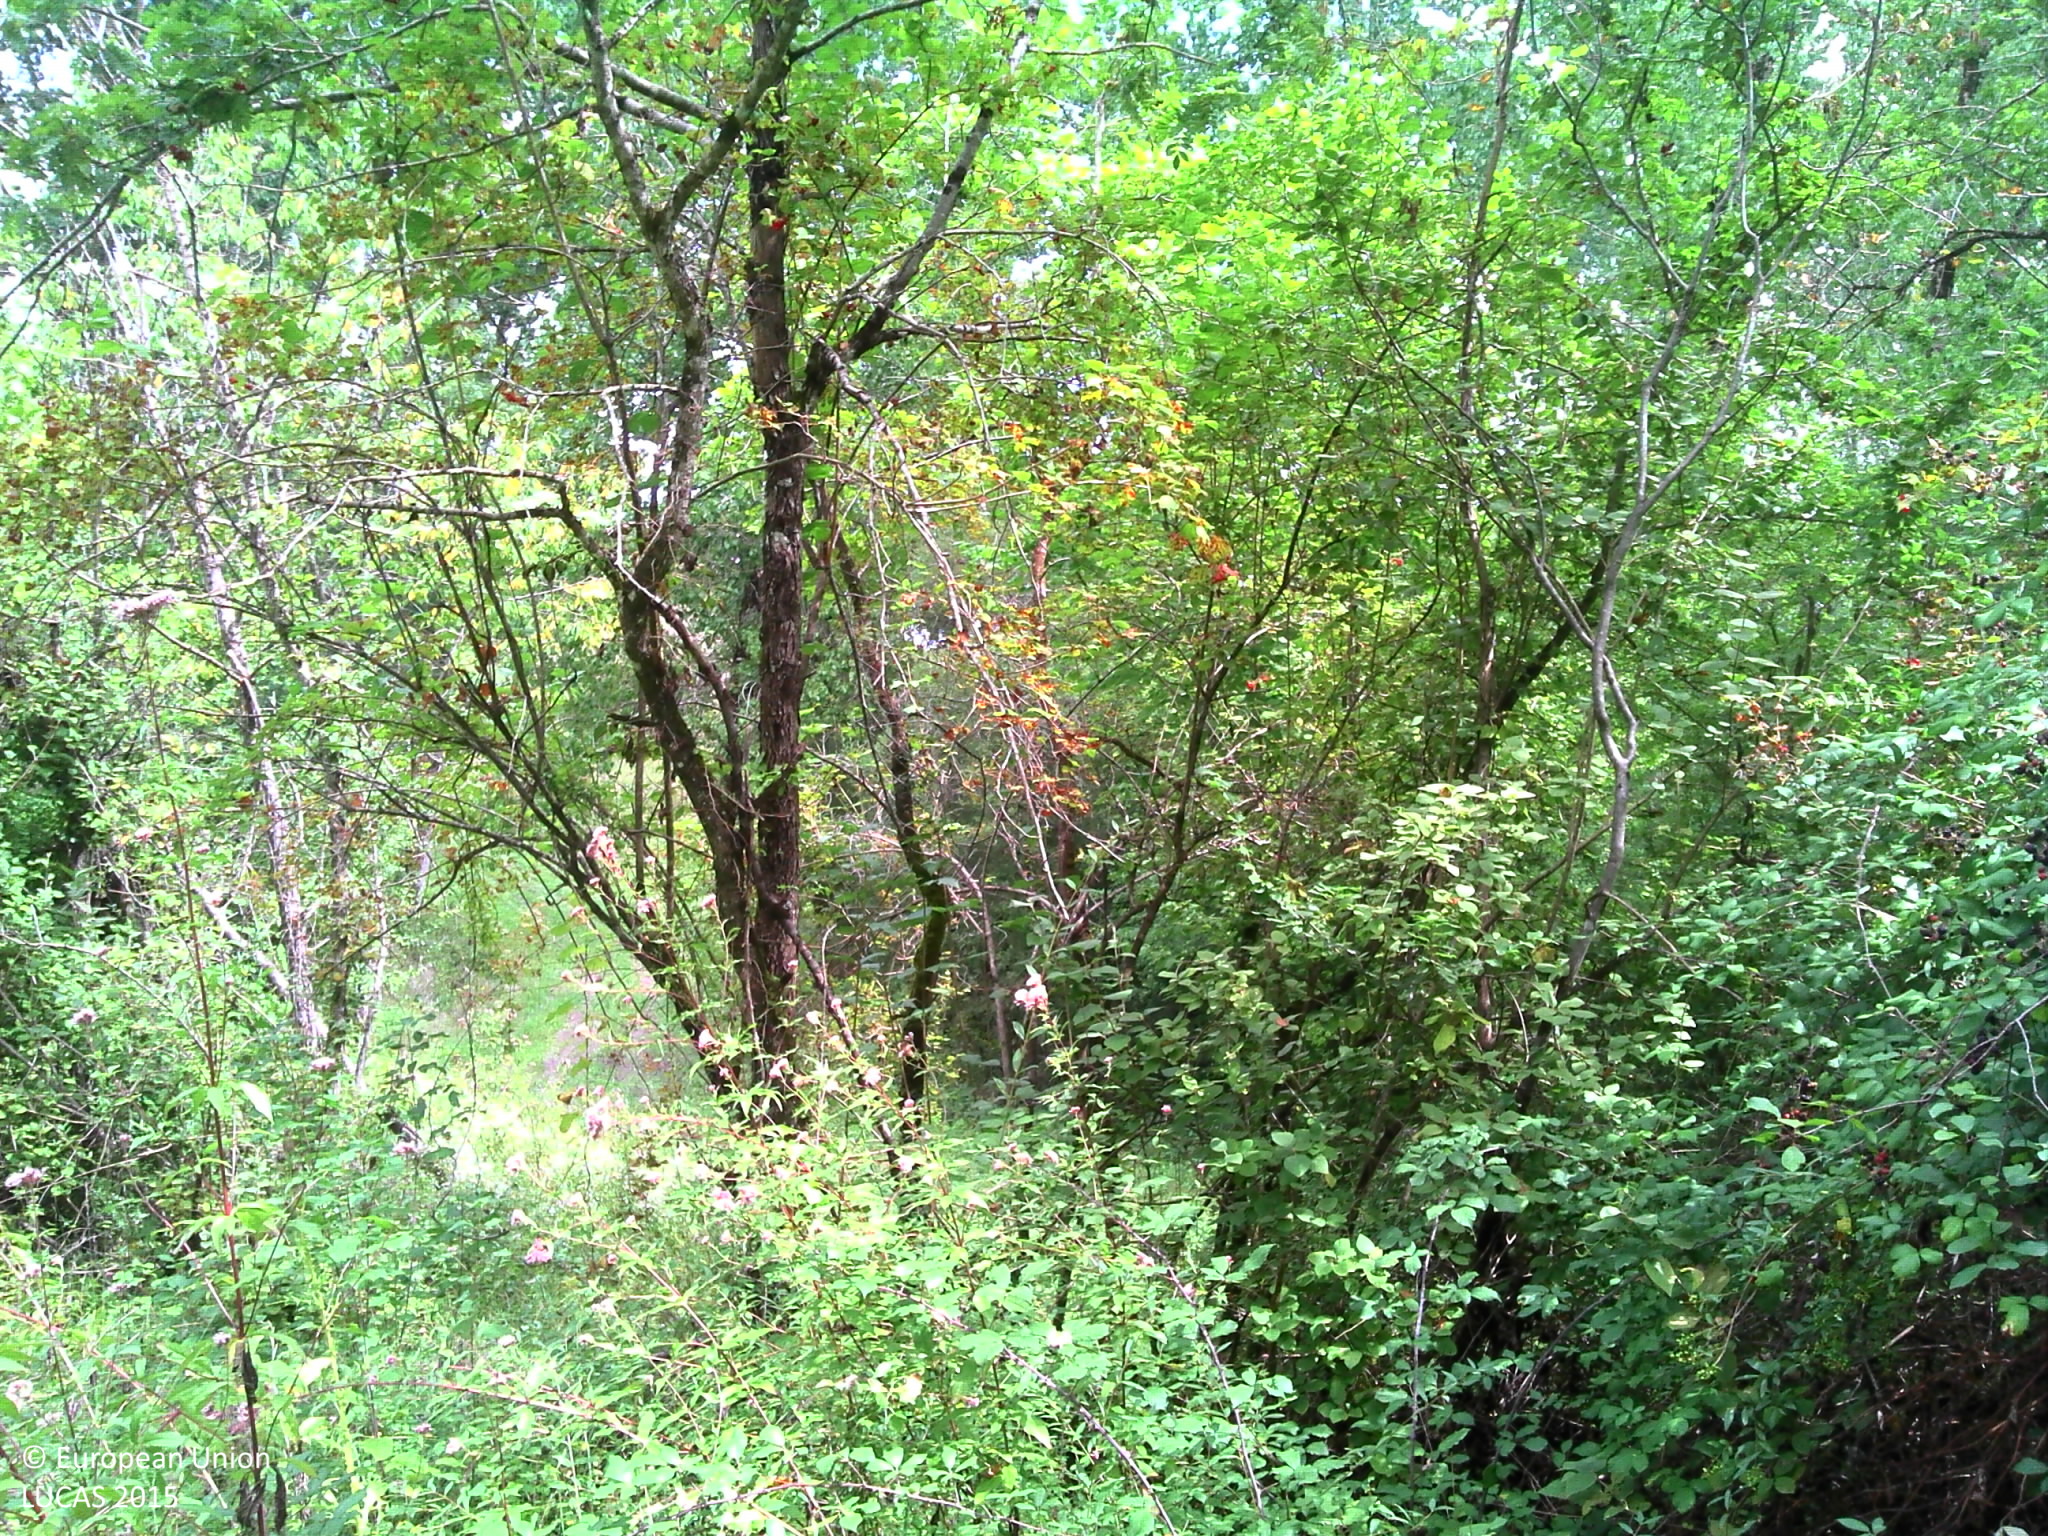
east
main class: Woodland
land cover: Broadleaved woodland
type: mesophytic deciduous forest
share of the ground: > 75 %
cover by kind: broadleaved forest trees 70 %, shrubs 20 %, herbaceous plants 10 %
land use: Forestry
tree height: > 5 m
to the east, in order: Broadleaved woodland; Tracks; Broadleaved woodland; Tracks; Grassland without tree/shrub cover; Durum wheat; Grassland without tree/shrub cover
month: August
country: FR
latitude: 45.2872
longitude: 0.4381
